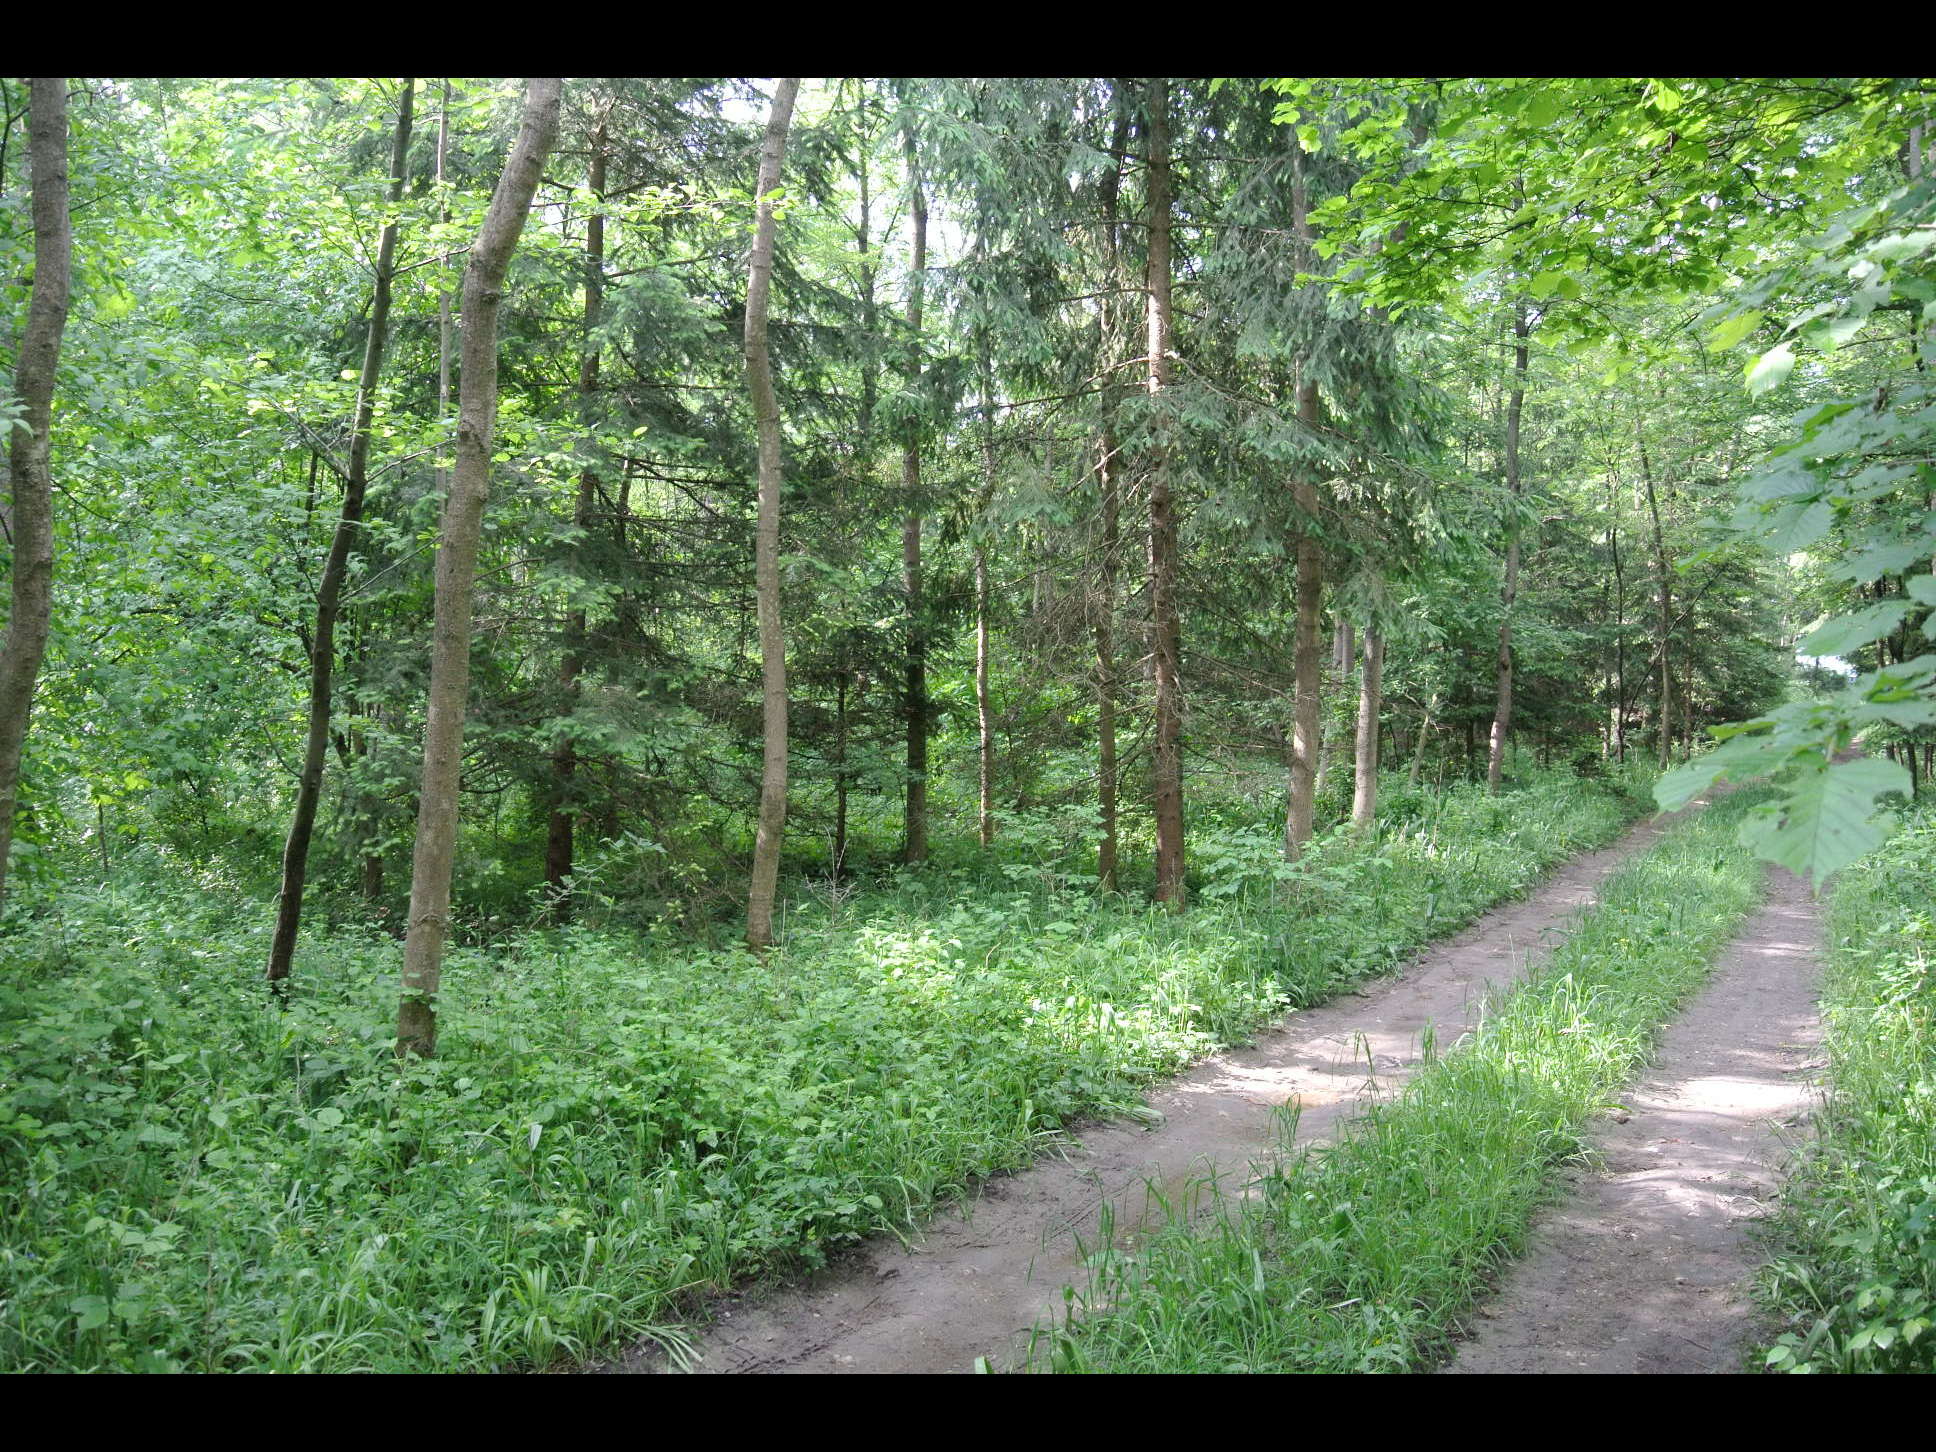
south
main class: Woodland
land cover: Broadleaved woodland
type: beech forest
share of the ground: > 75 %
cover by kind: broadleaved forest trees 90 %, coniferous forest trees 10 %
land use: Forestry
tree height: > 5 m
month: May
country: AT
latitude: 48.0443
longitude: 16.5918
